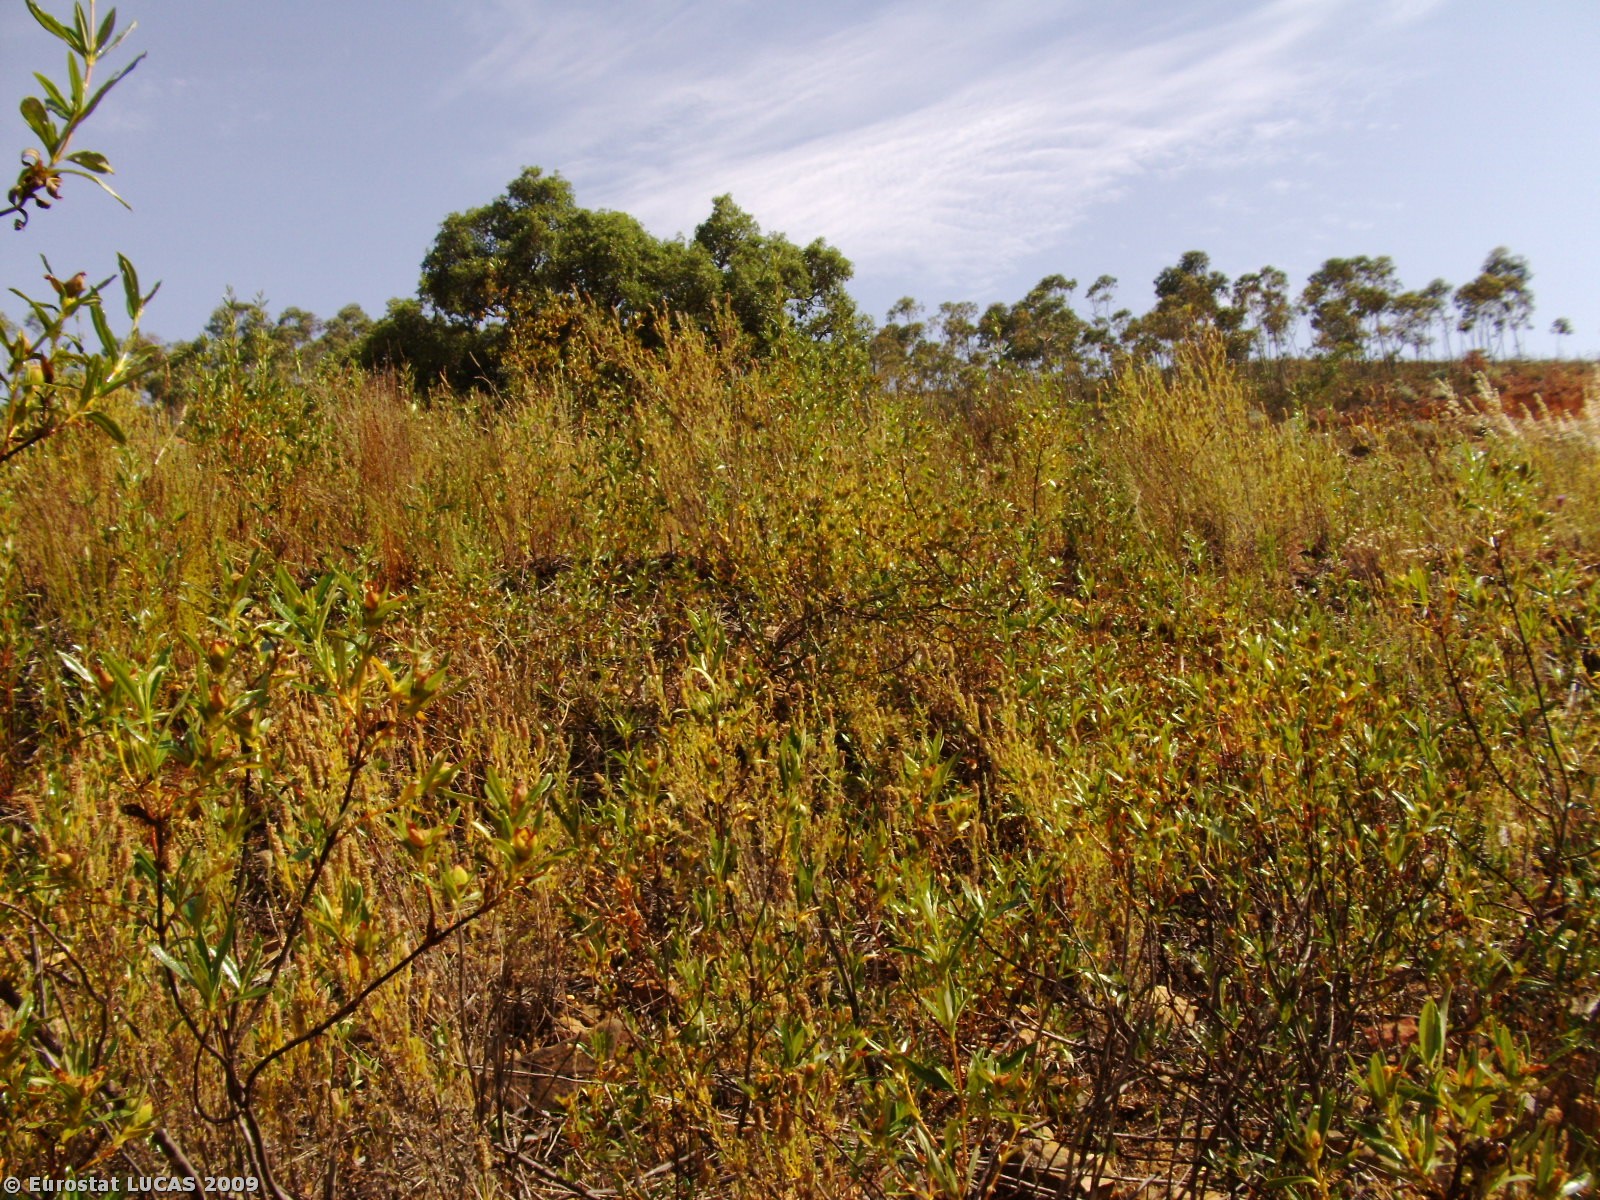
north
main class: Shrubland
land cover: Shrubland with sparse tree cover
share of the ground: > 75 %
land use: Unused
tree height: > 5 m
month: June
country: PT
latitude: 37.3499
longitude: -8.7411
